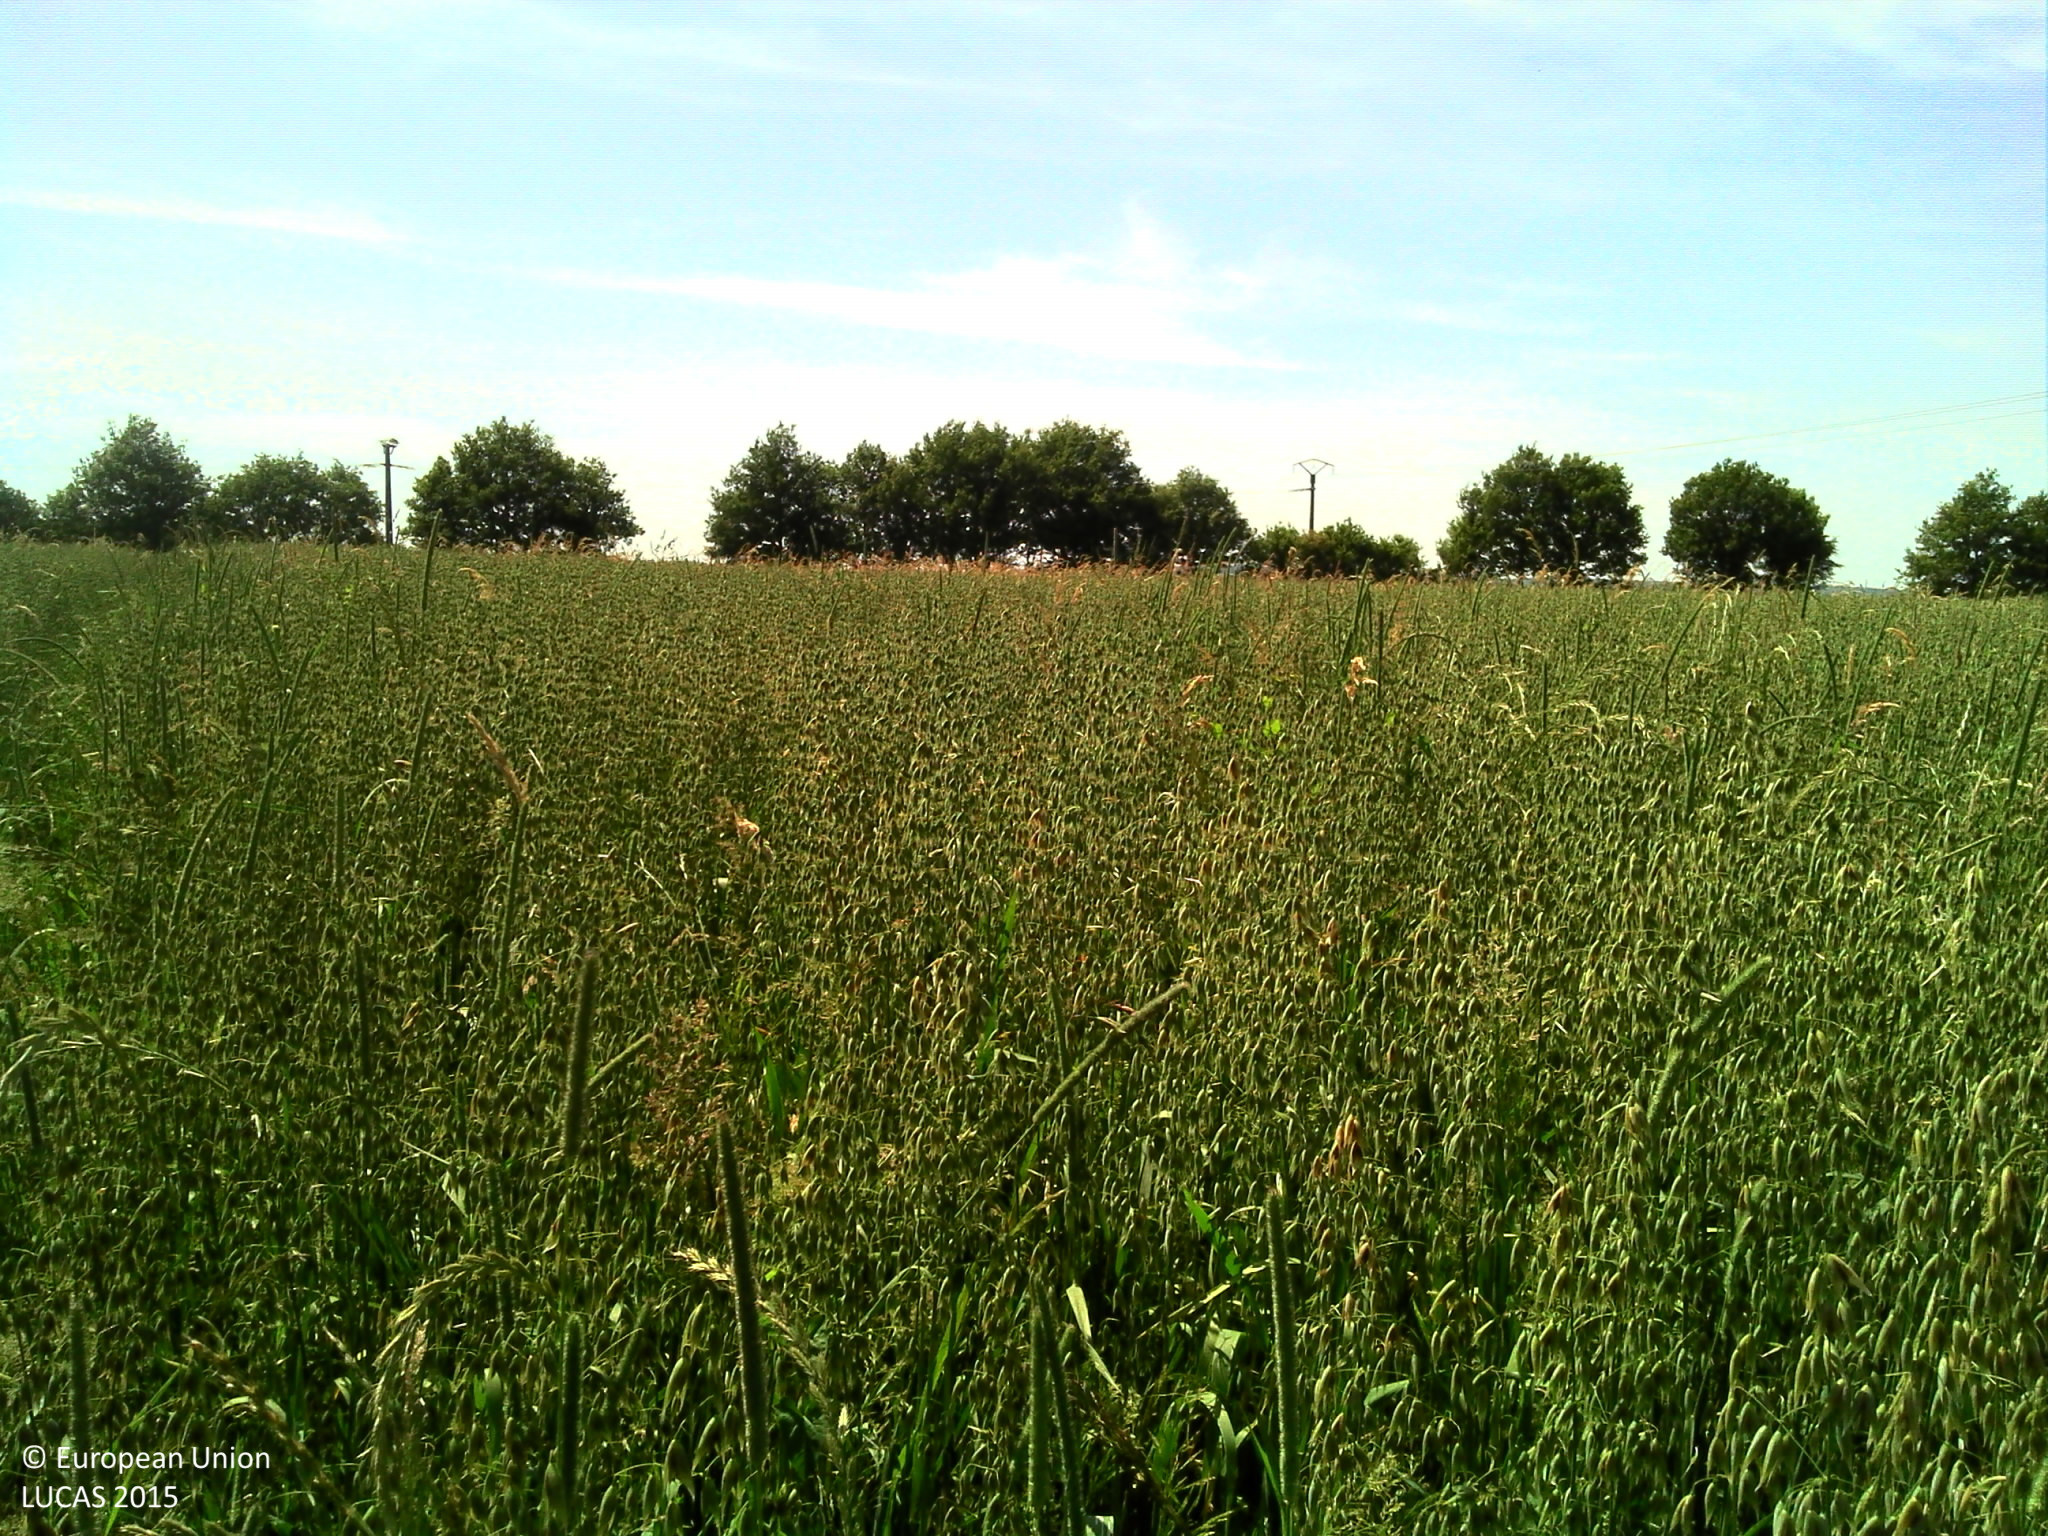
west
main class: Cropland
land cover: Oats
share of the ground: > 75 %
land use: Agriculture (excluding fallow land and kitchen gardens)
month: June
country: FR
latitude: 47.9908
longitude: -2.1002
